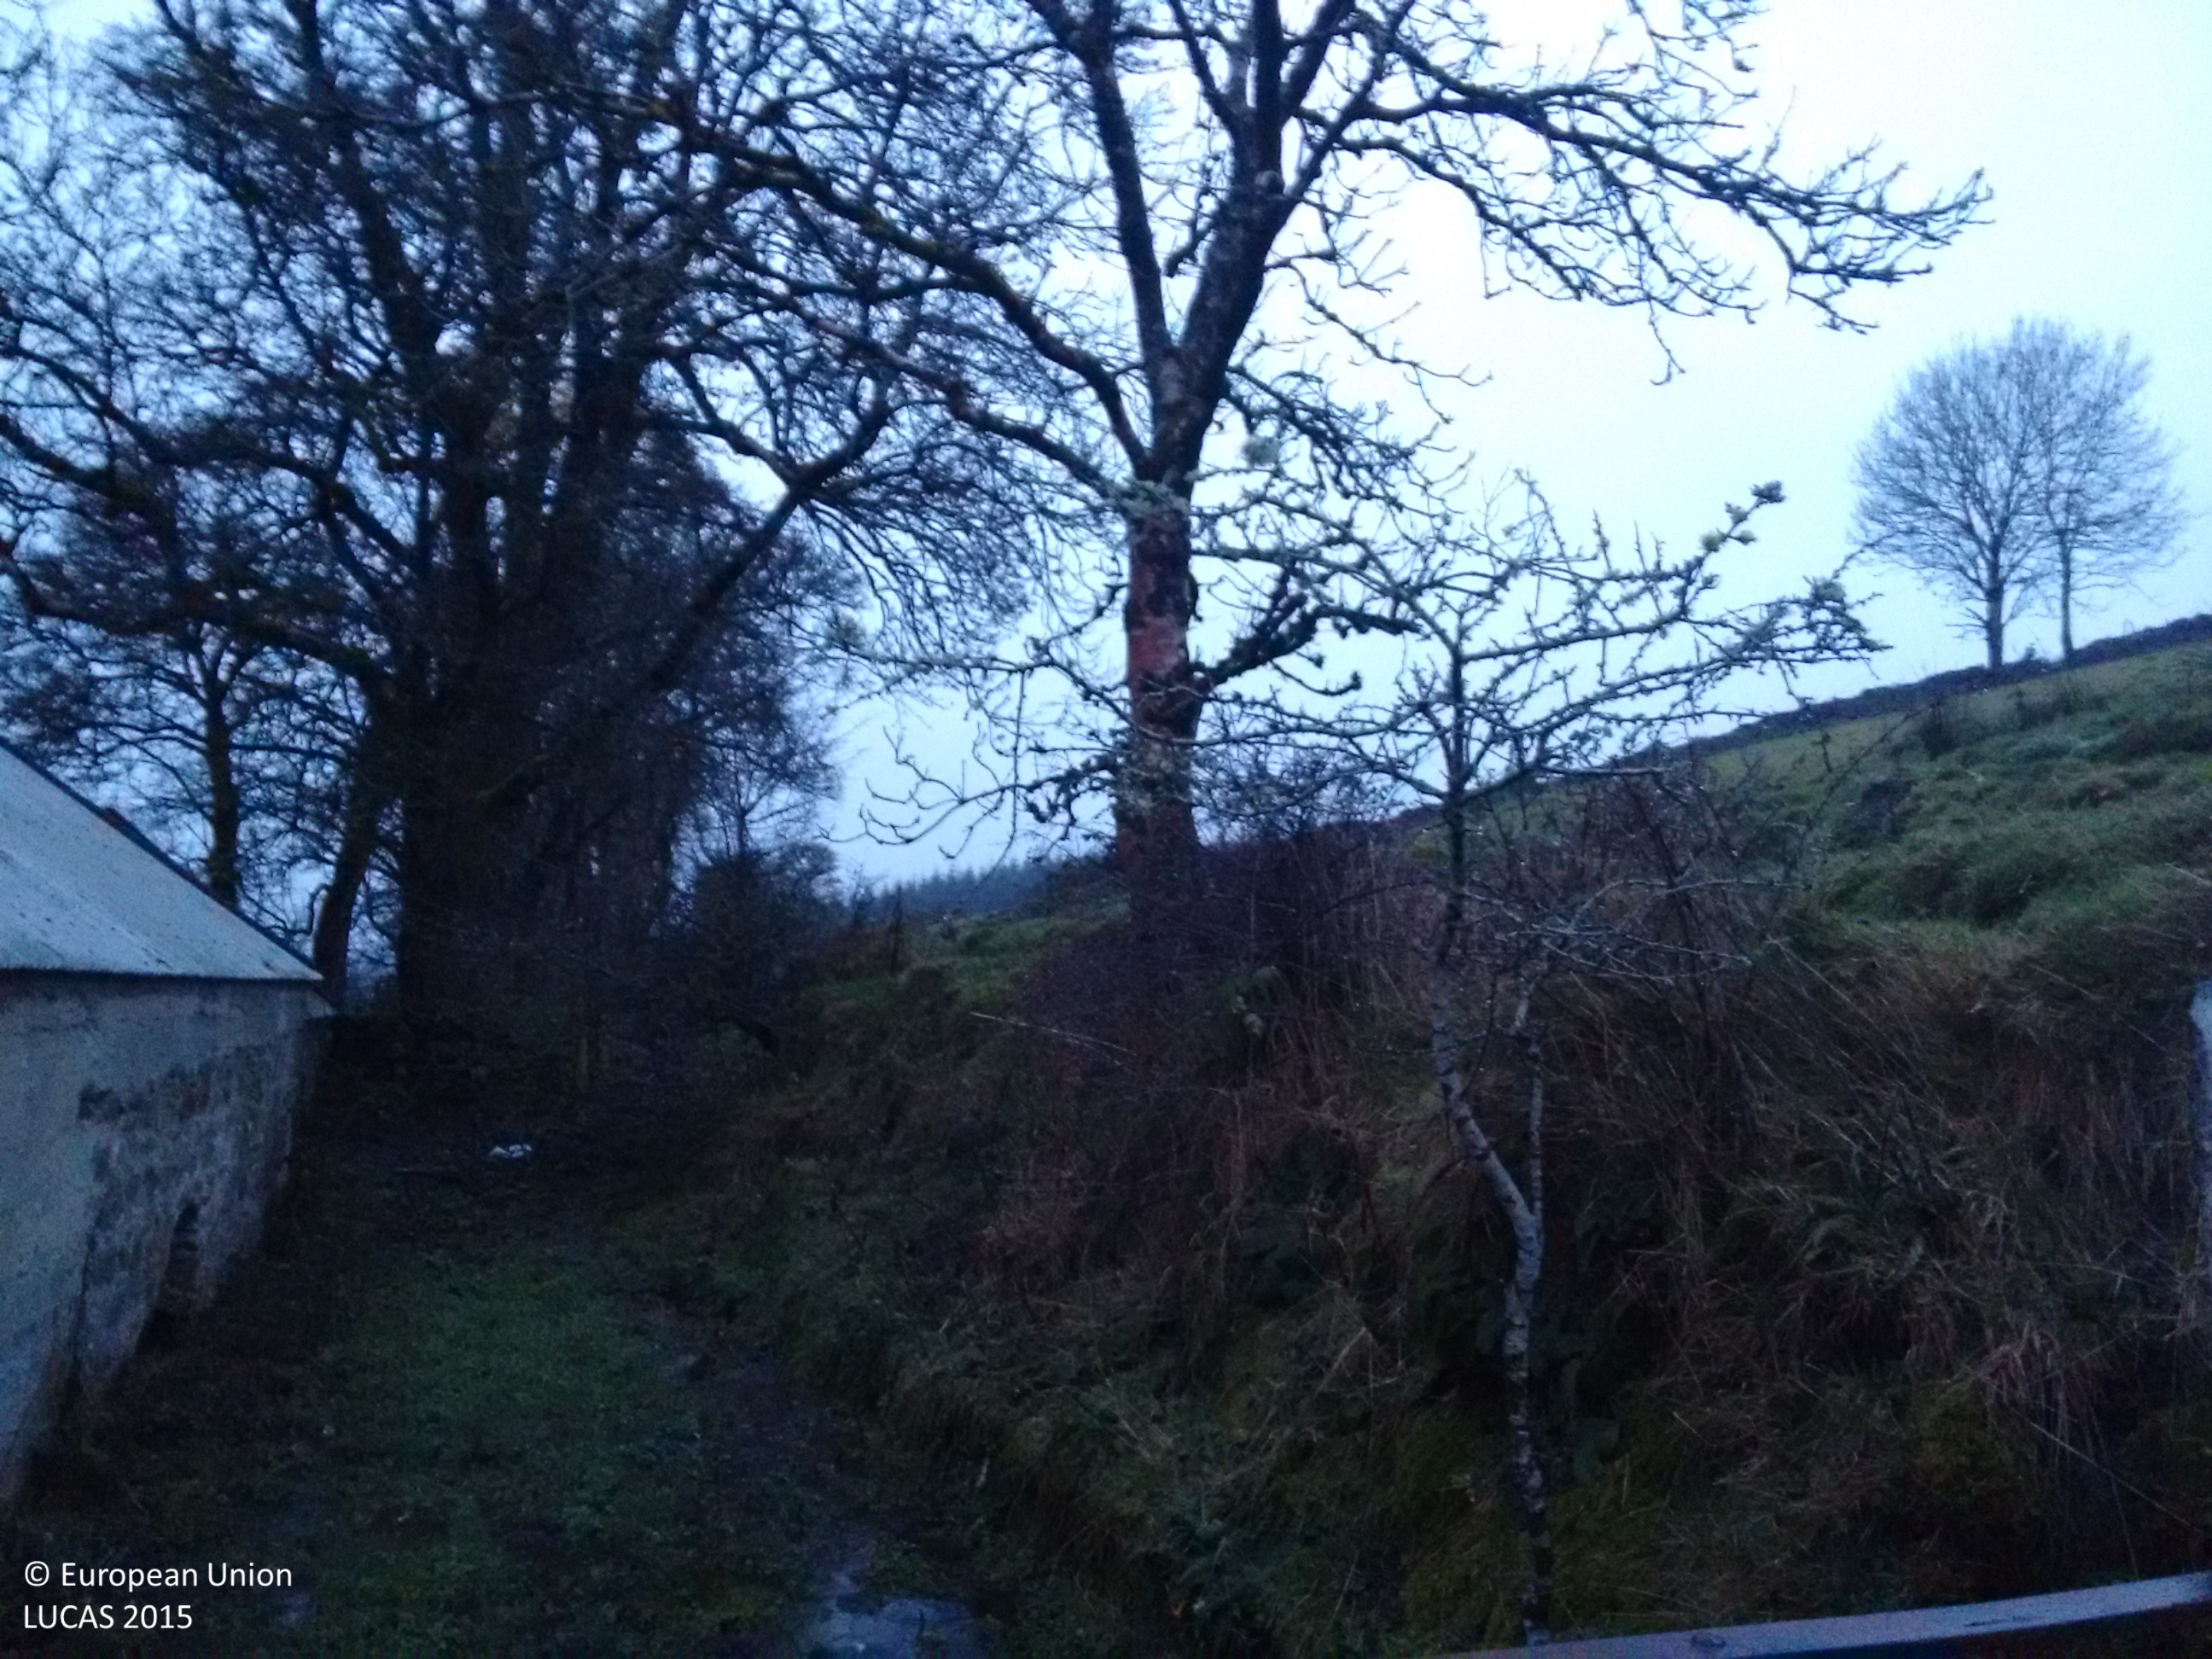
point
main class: Grassland
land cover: Grassland without tree/shrub cover
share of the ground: > 75 %
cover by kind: herbaceous plants 100 %
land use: Agriculture (excluding fallow land and kitchen gardens)
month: November
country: IE
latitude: 54.1295
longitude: -8.3197
